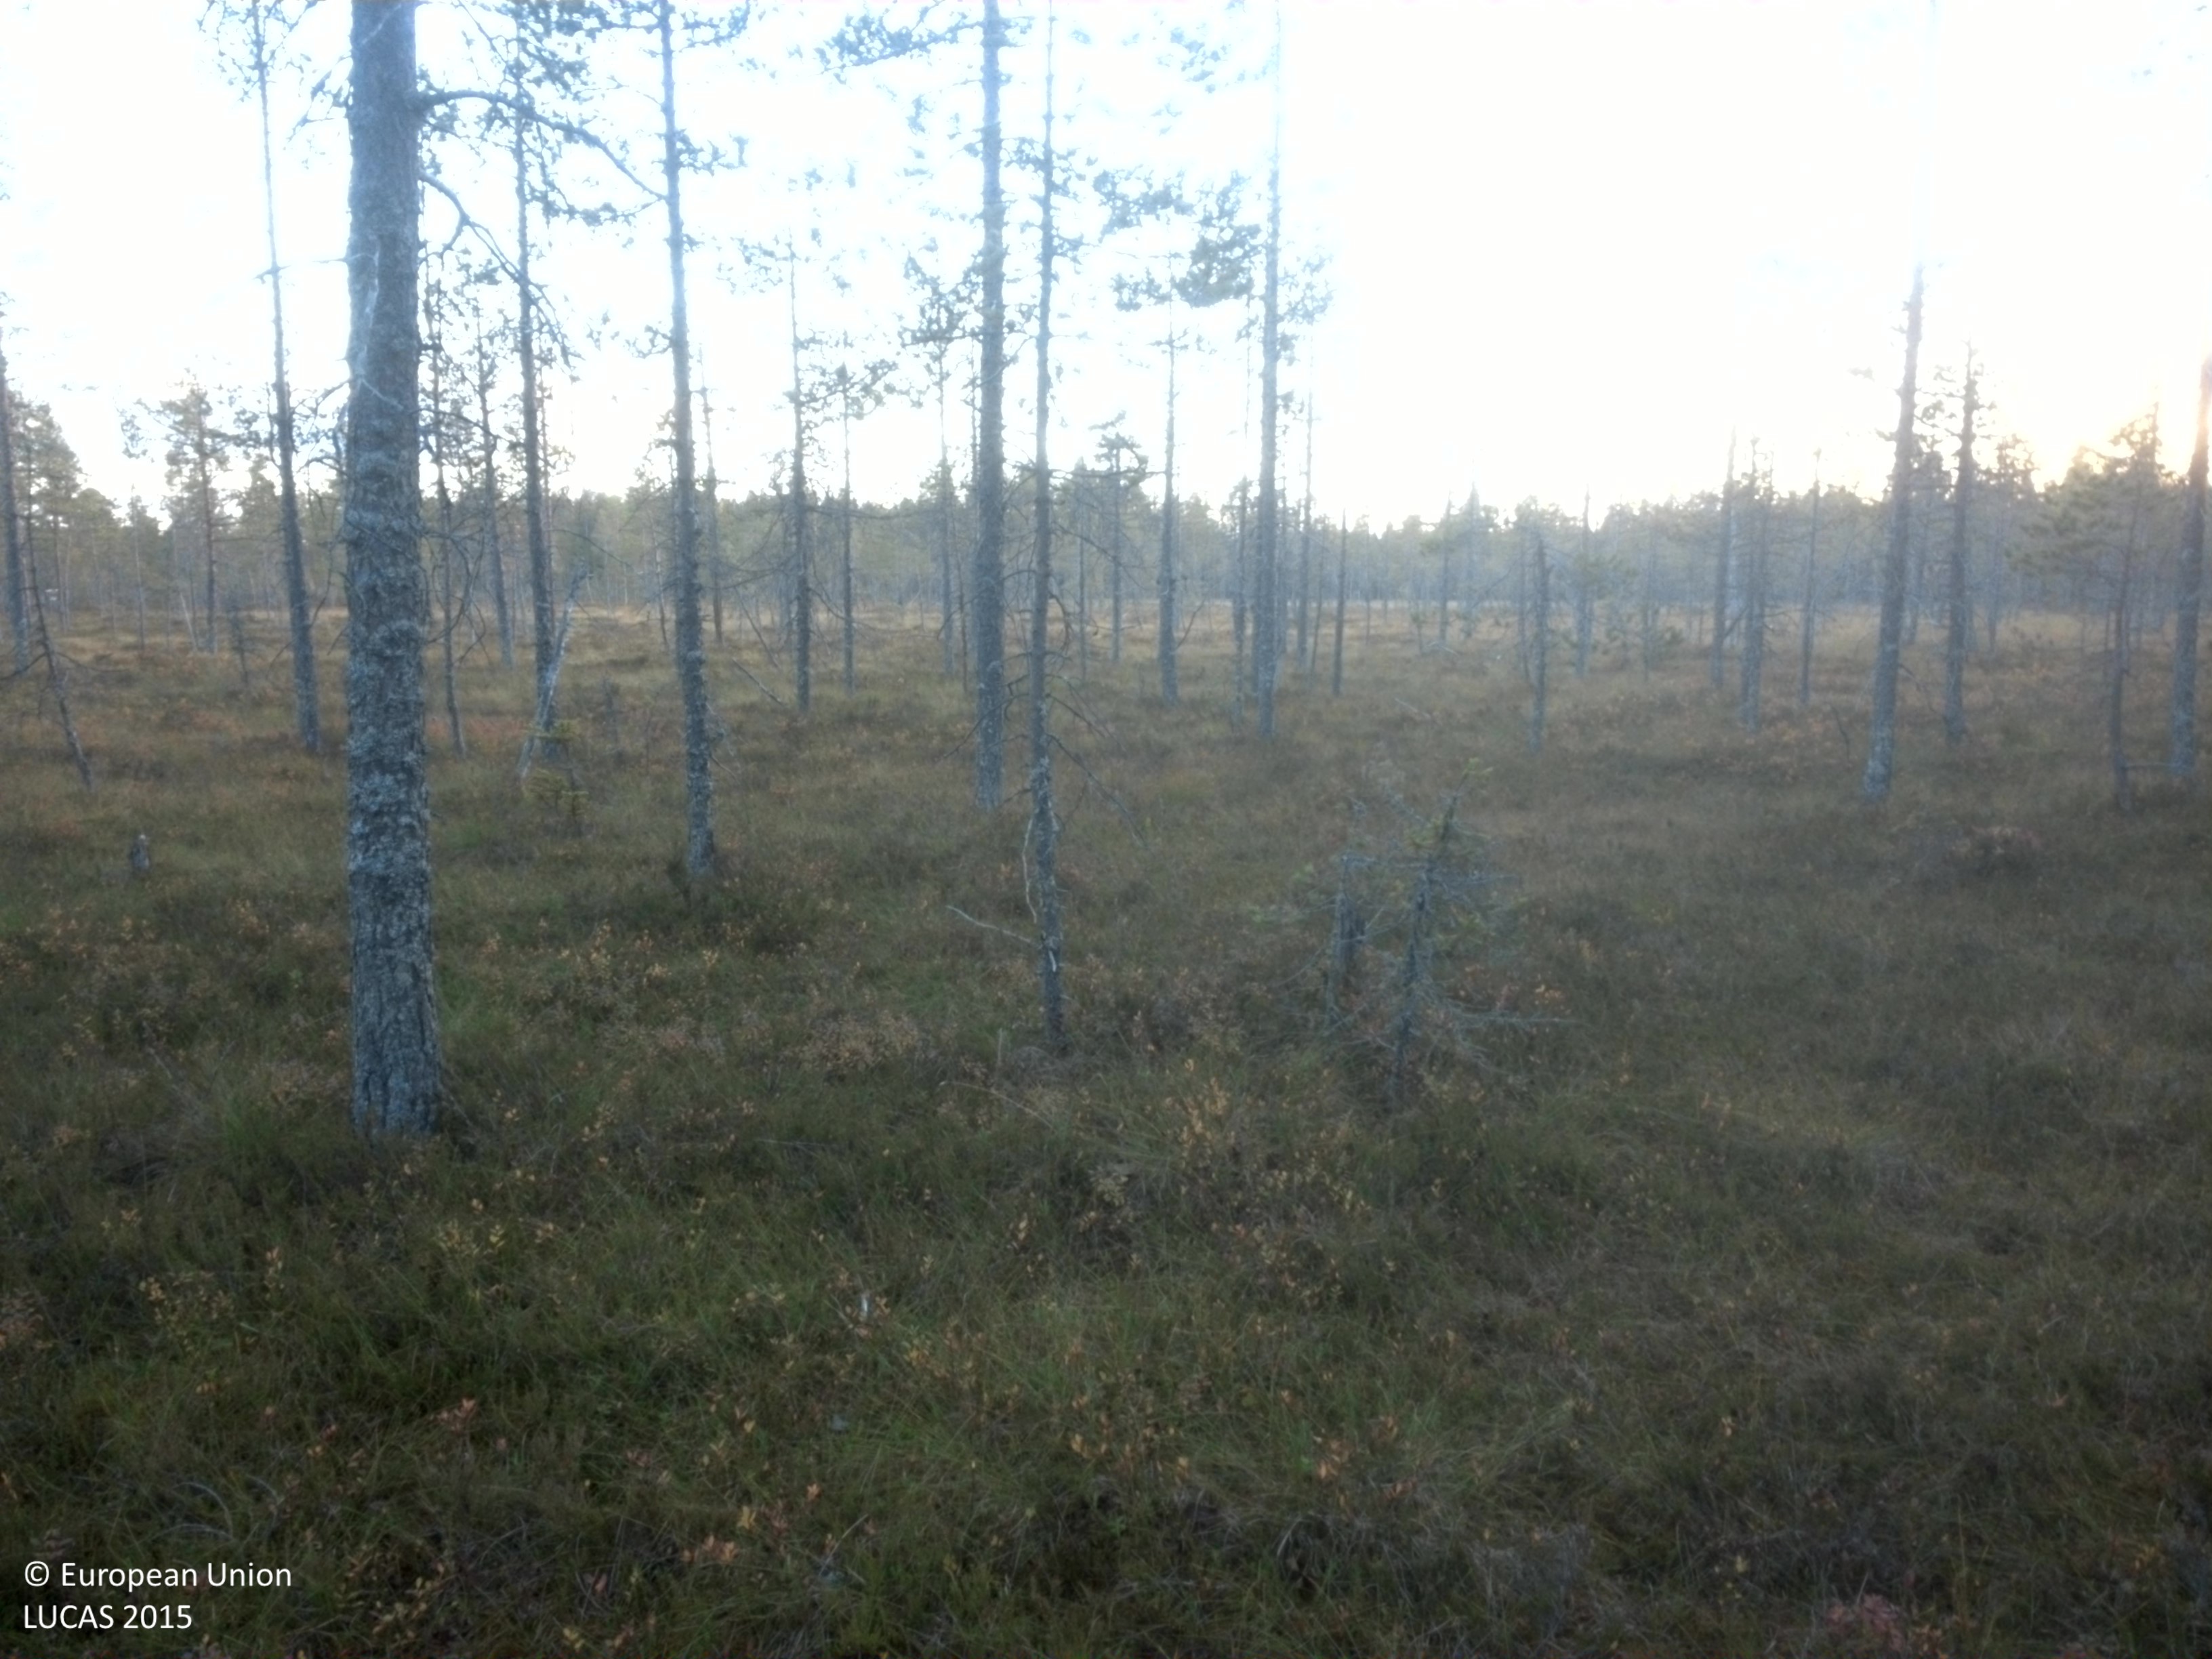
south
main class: Woodland
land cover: Pine dominated coniferous woodland
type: mire and swamp forests
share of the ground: 25 - 50 %
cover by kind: shrubs 40 %, coniferous forest trees 35 %, herbaceous plants 15 %, lichens and mosses 10 %
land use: Semi-natural and natural areas not in use
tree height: > 5 m
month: September
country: SE
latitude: 64.1833
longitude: 20.1240
